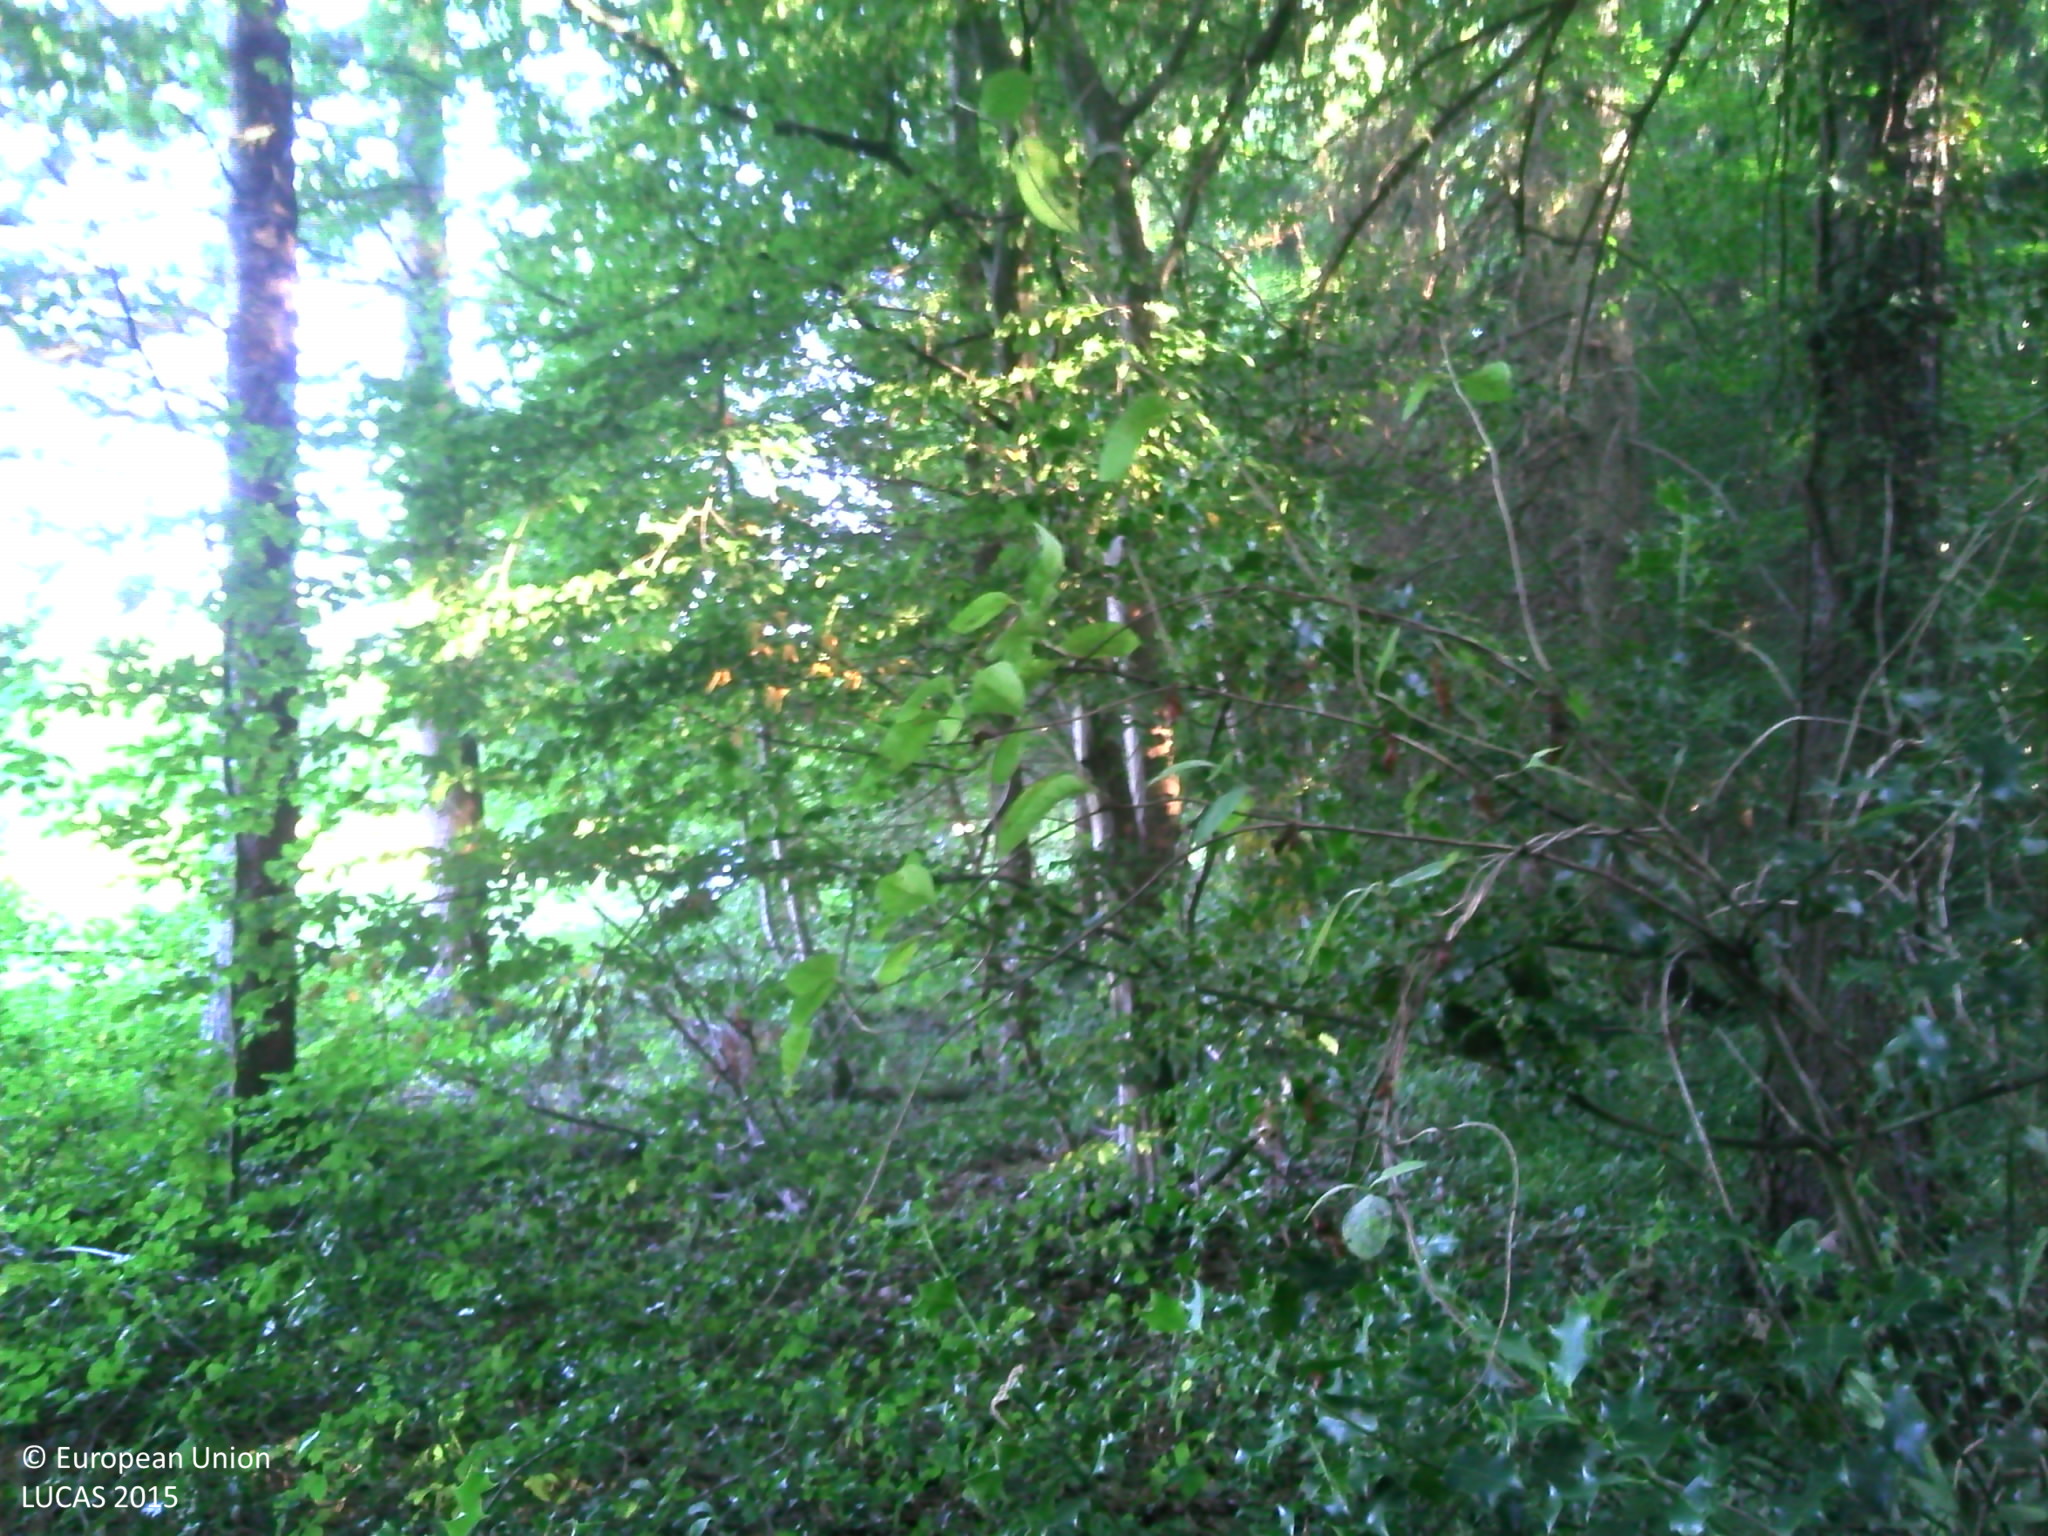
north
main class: Woodland
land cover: Spruce dominated mixed woodland
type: mesophytic deciduous forest
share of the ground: > 75 %
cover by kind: coniferous forest trees 50 %, herbaceous plants 30 %, broadleaved forest trees 20 %
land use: Forestry
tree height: > 5 m
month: August
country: FR
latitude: 46.4071
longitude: 4.8379
